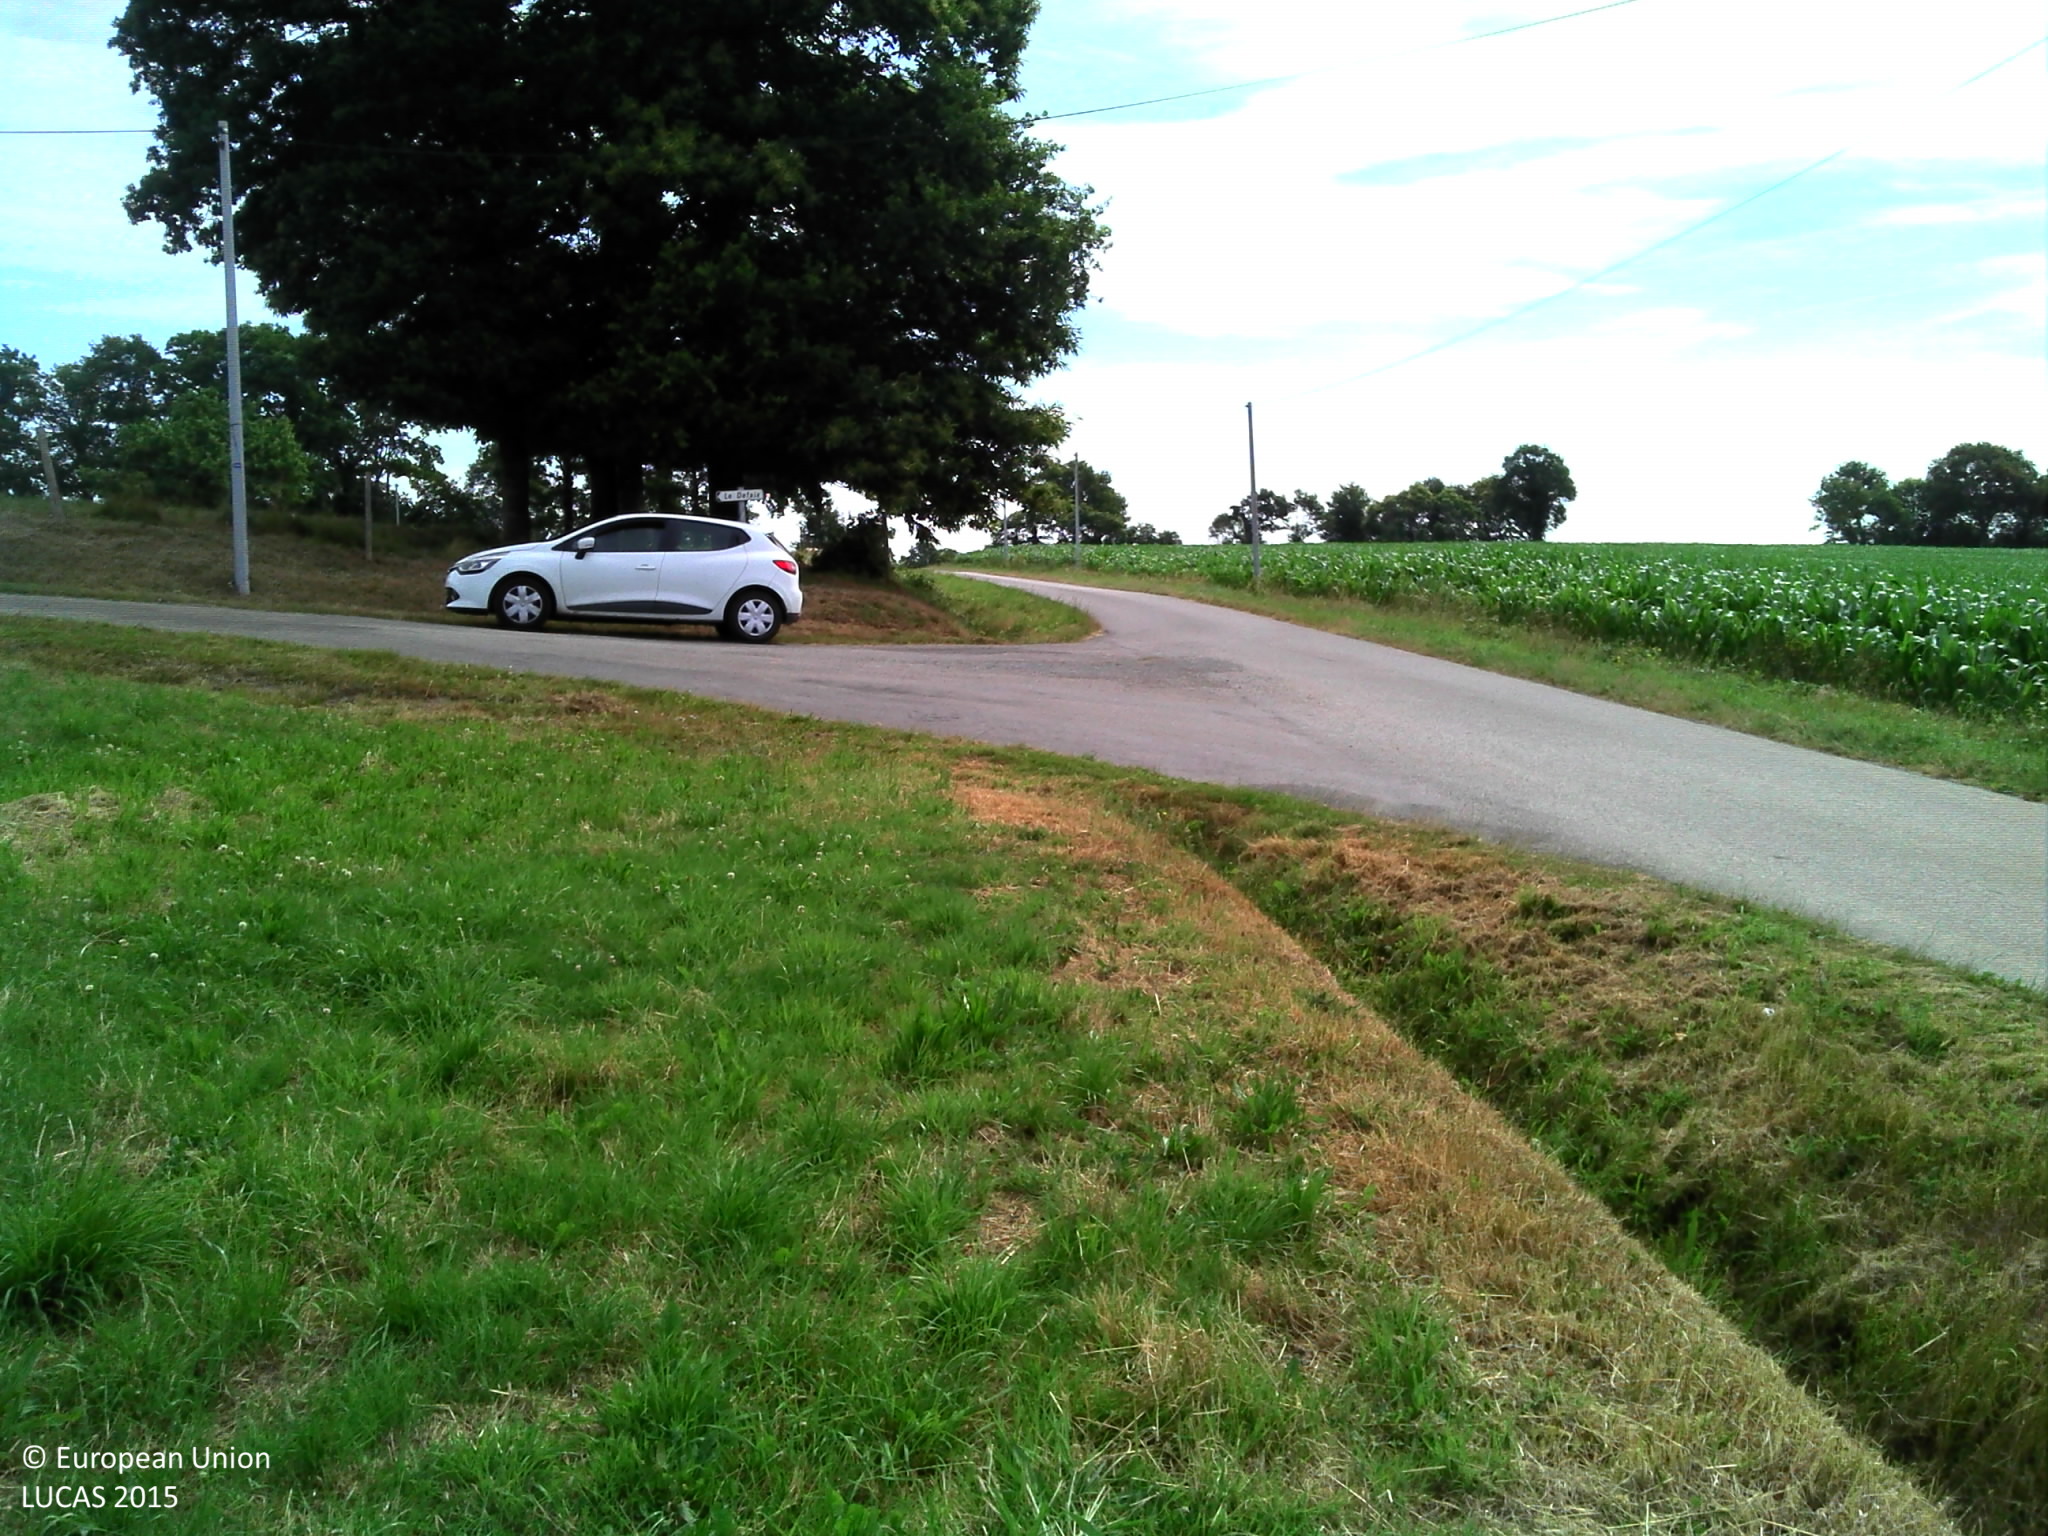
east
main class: Cropland
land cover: Apple fruit
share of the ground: > 75 %
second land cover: Grassland without tree/shrub cover
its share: > 75 %
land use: Agriculture (excluding fallow land and kitchen gardens)
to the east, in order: Apple fruit; Grassland without tree/shrub cover; Ditches and canals; Grass margins; Paved roads, cycling and walking lanes; Grass margins; Electric lines; Maize; Lines of trees; Grass margins; Tracks; Grass margins; Ditches and canals; Fences; Grassland without tree/shrub cover
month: June
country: FR
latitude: 47.9362
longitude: -1.5984
